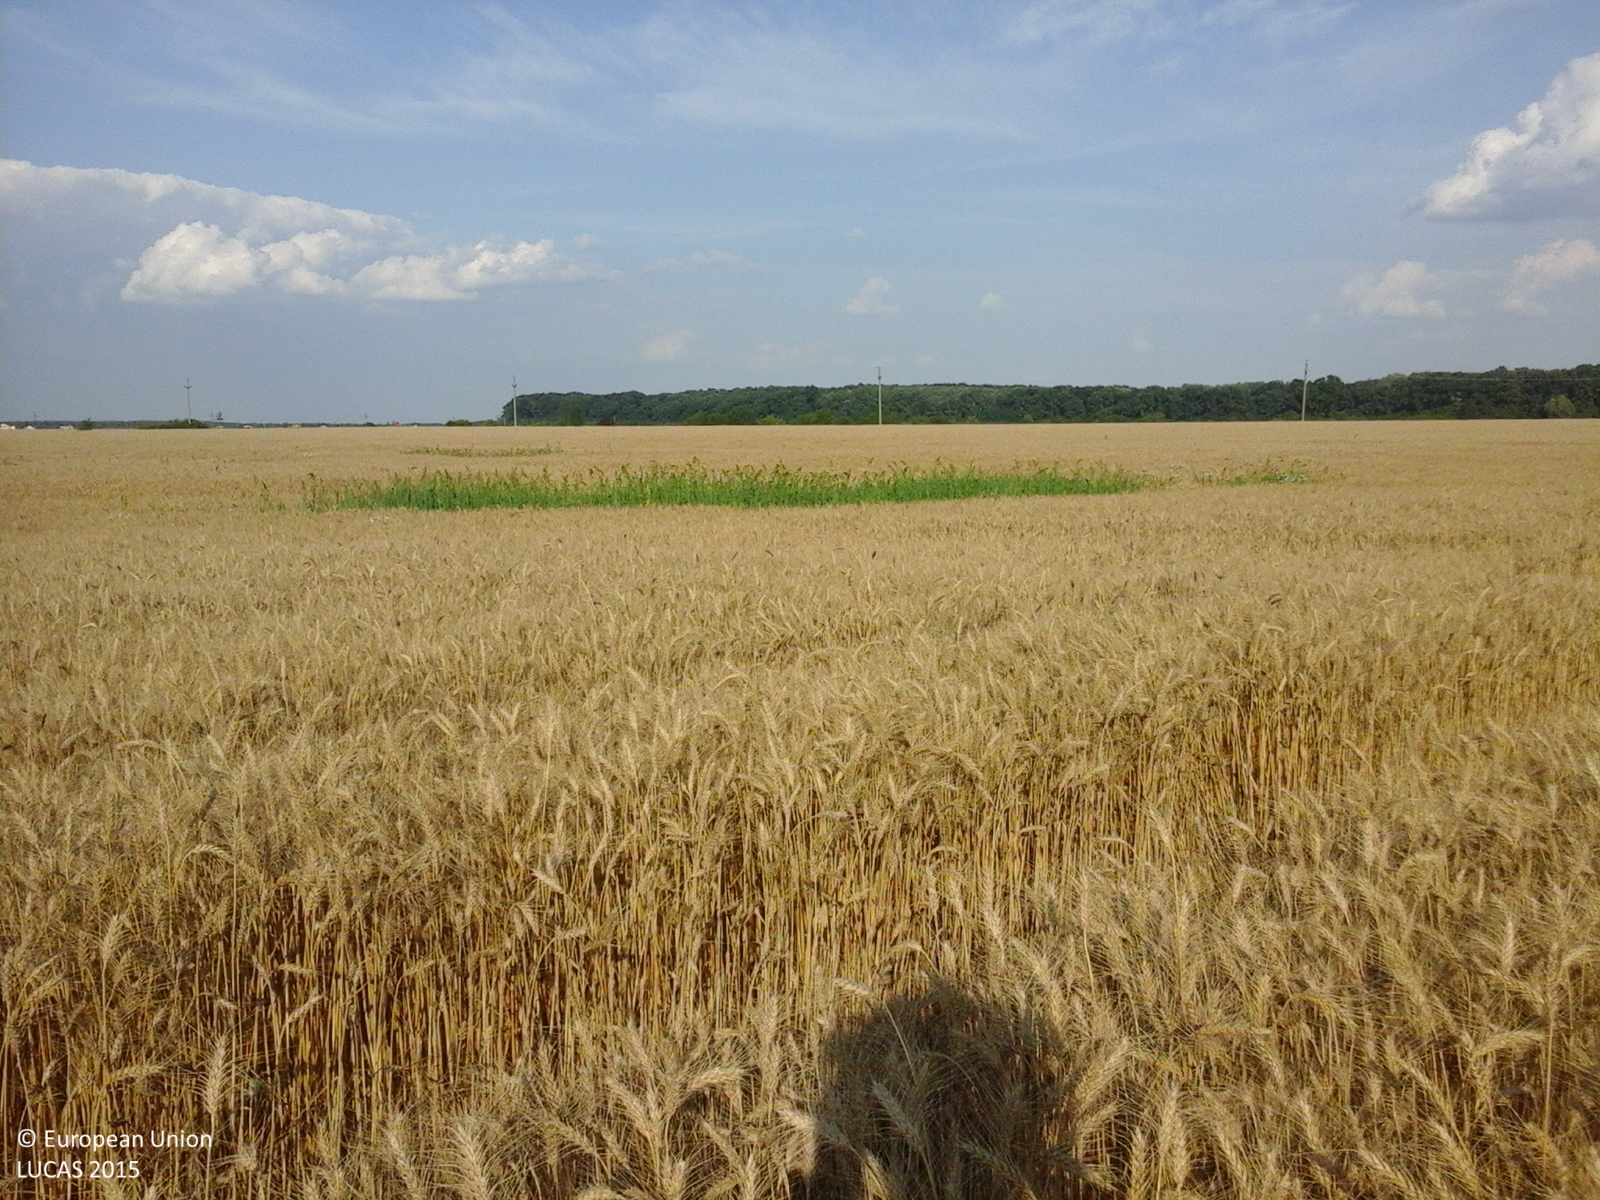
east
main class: Cropland
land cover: Common wheat
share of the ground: > 75 %
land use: Agriculture (excluding fallow land and kitchen gardens)
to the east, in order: Common wheat
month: June
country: RO
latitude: 44.5707
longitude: 25.9824
